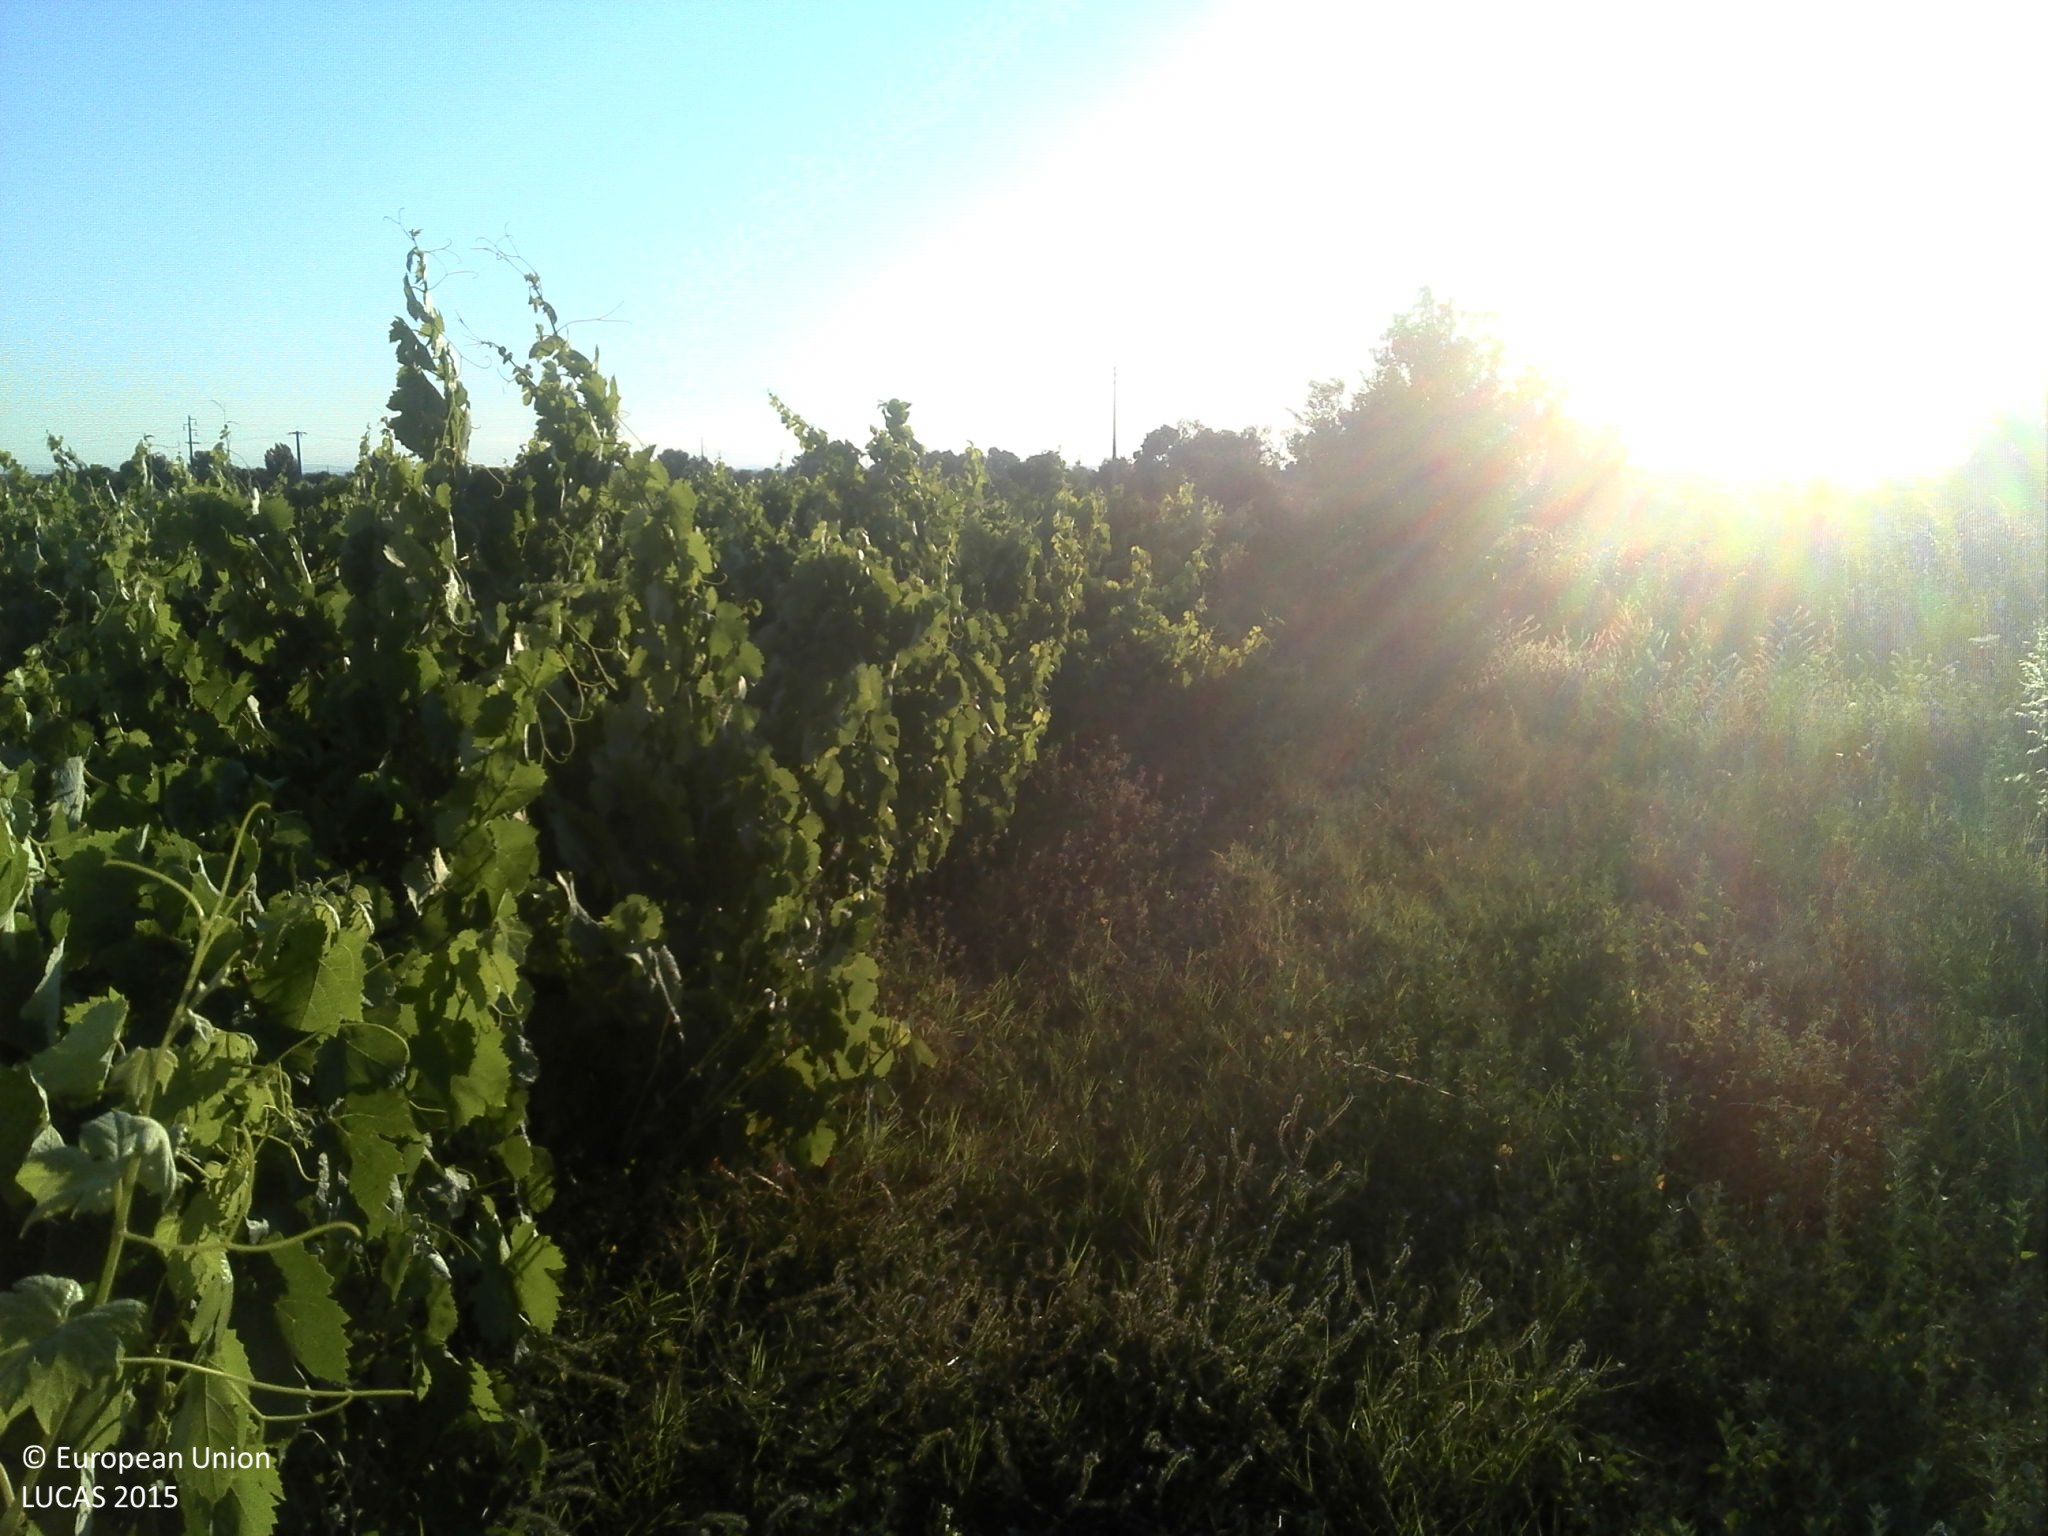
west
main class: Cropland
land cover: Vineyards
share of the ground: 25 - 50 %
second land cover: Grassland without tree/shrub cover
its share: 50 - 75 %
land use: Agriculture (excluding fallow land and kitchen gardens)
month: June
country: PT
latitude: 39.1170
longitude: -8.7032
